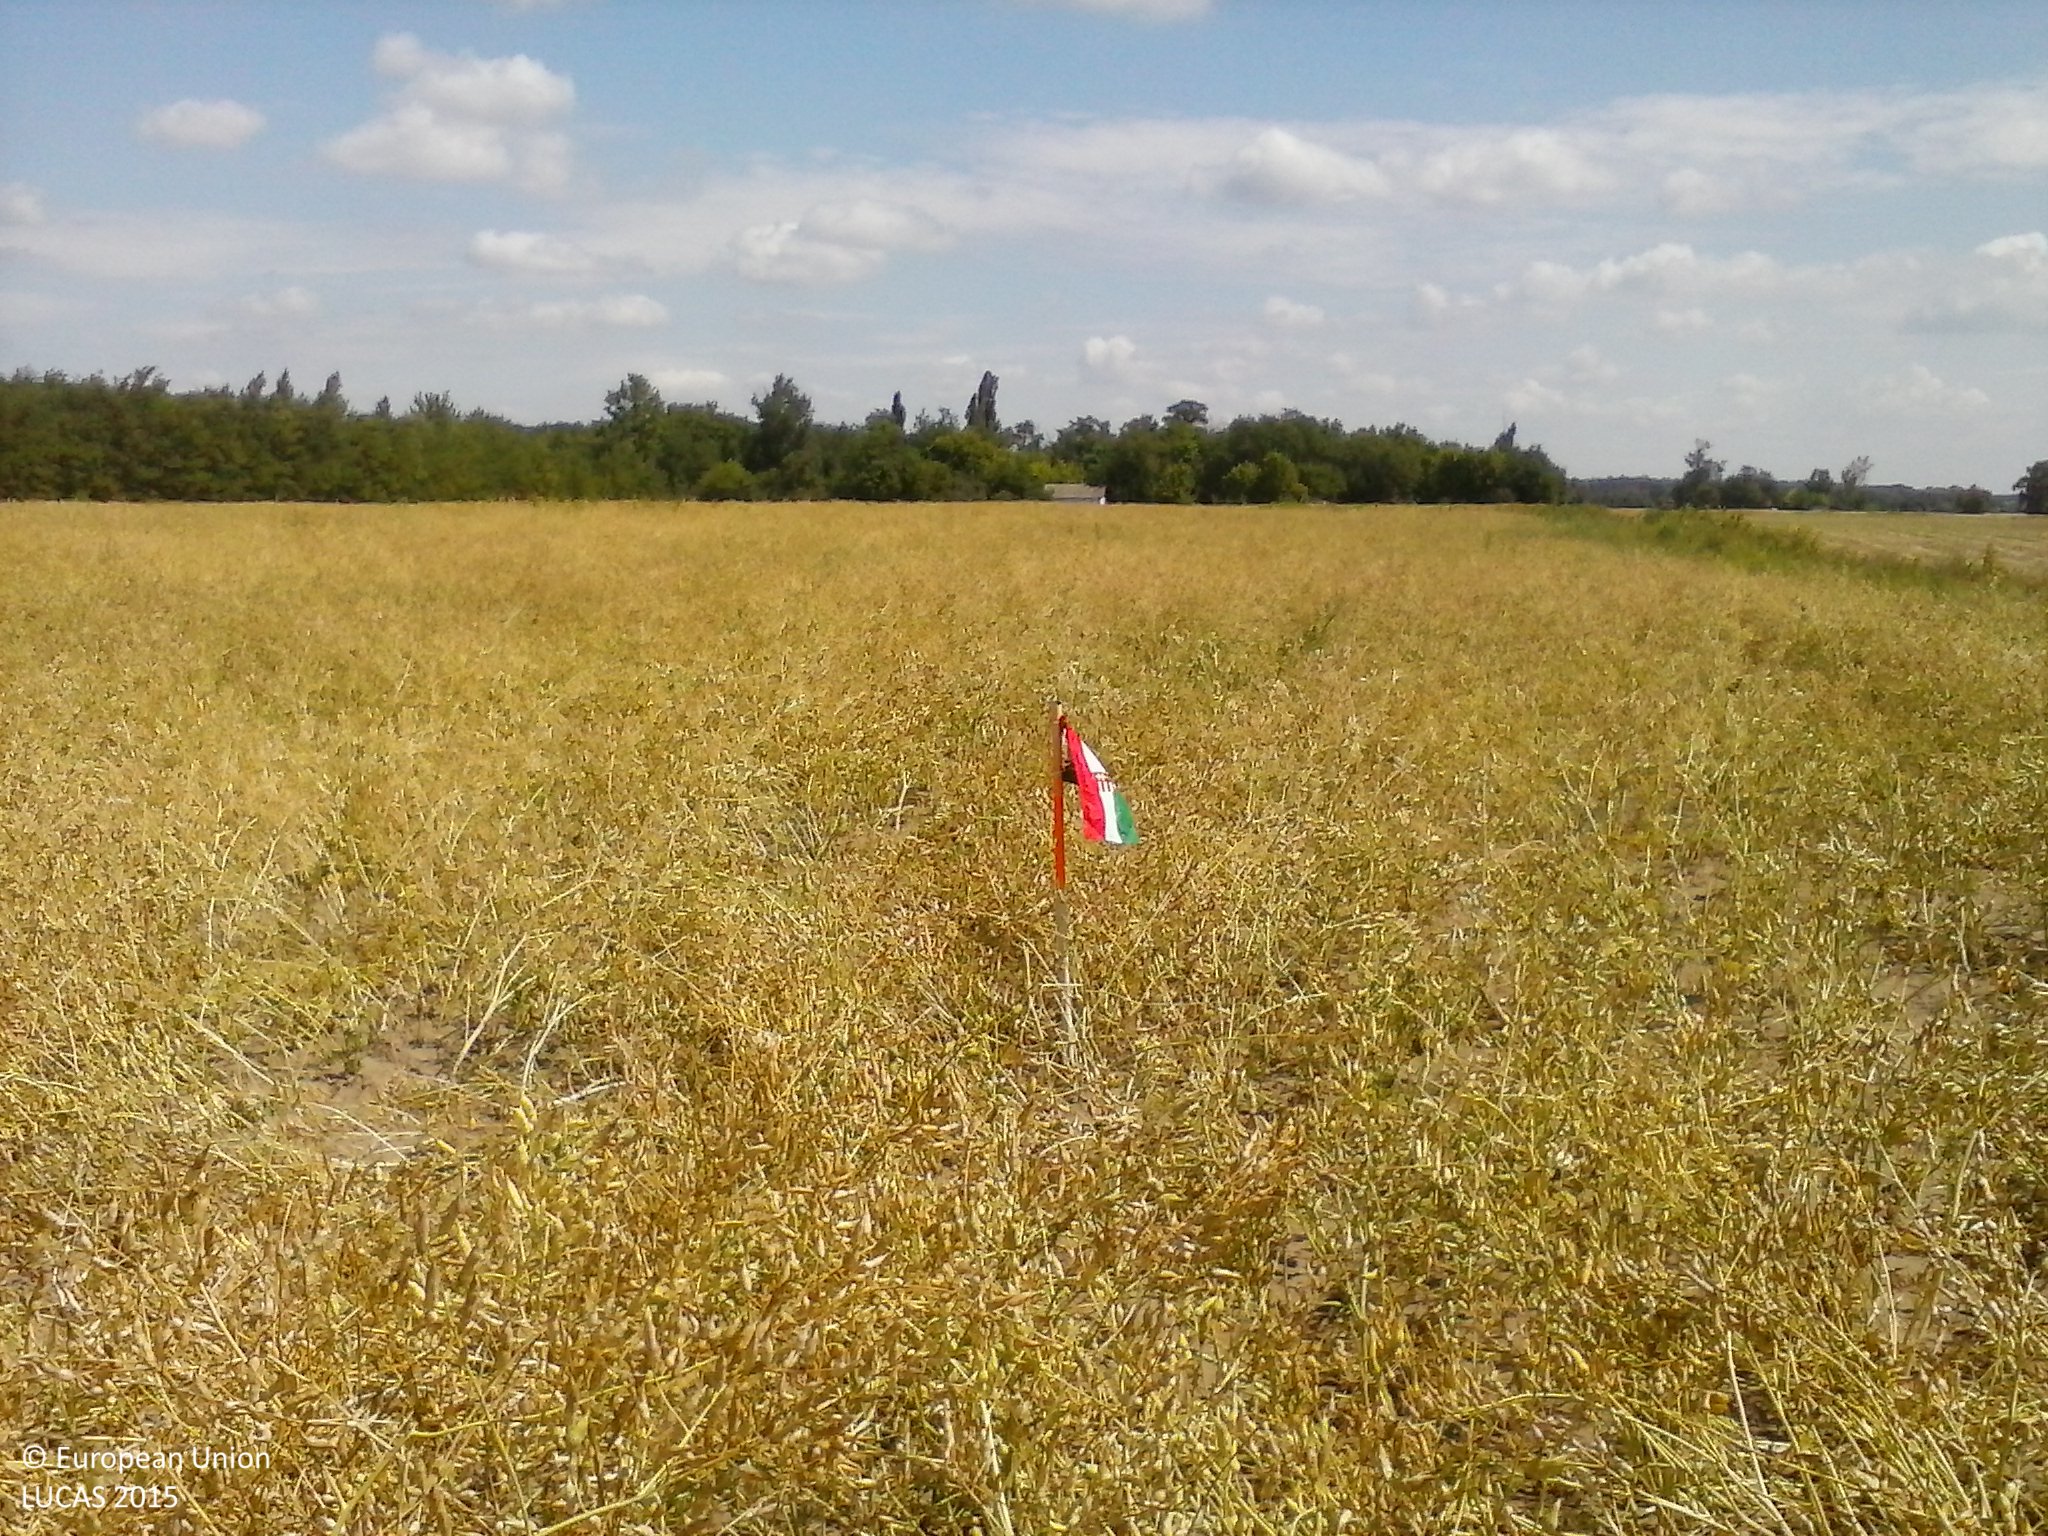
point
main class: Cropland
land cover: Other leguminous and mixtures for fodder
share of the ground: > 75 %
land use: Agriculture (excluding fallow land and kitchen gardens)
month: July
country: HU
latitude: 46.6062
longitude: 19.6147
